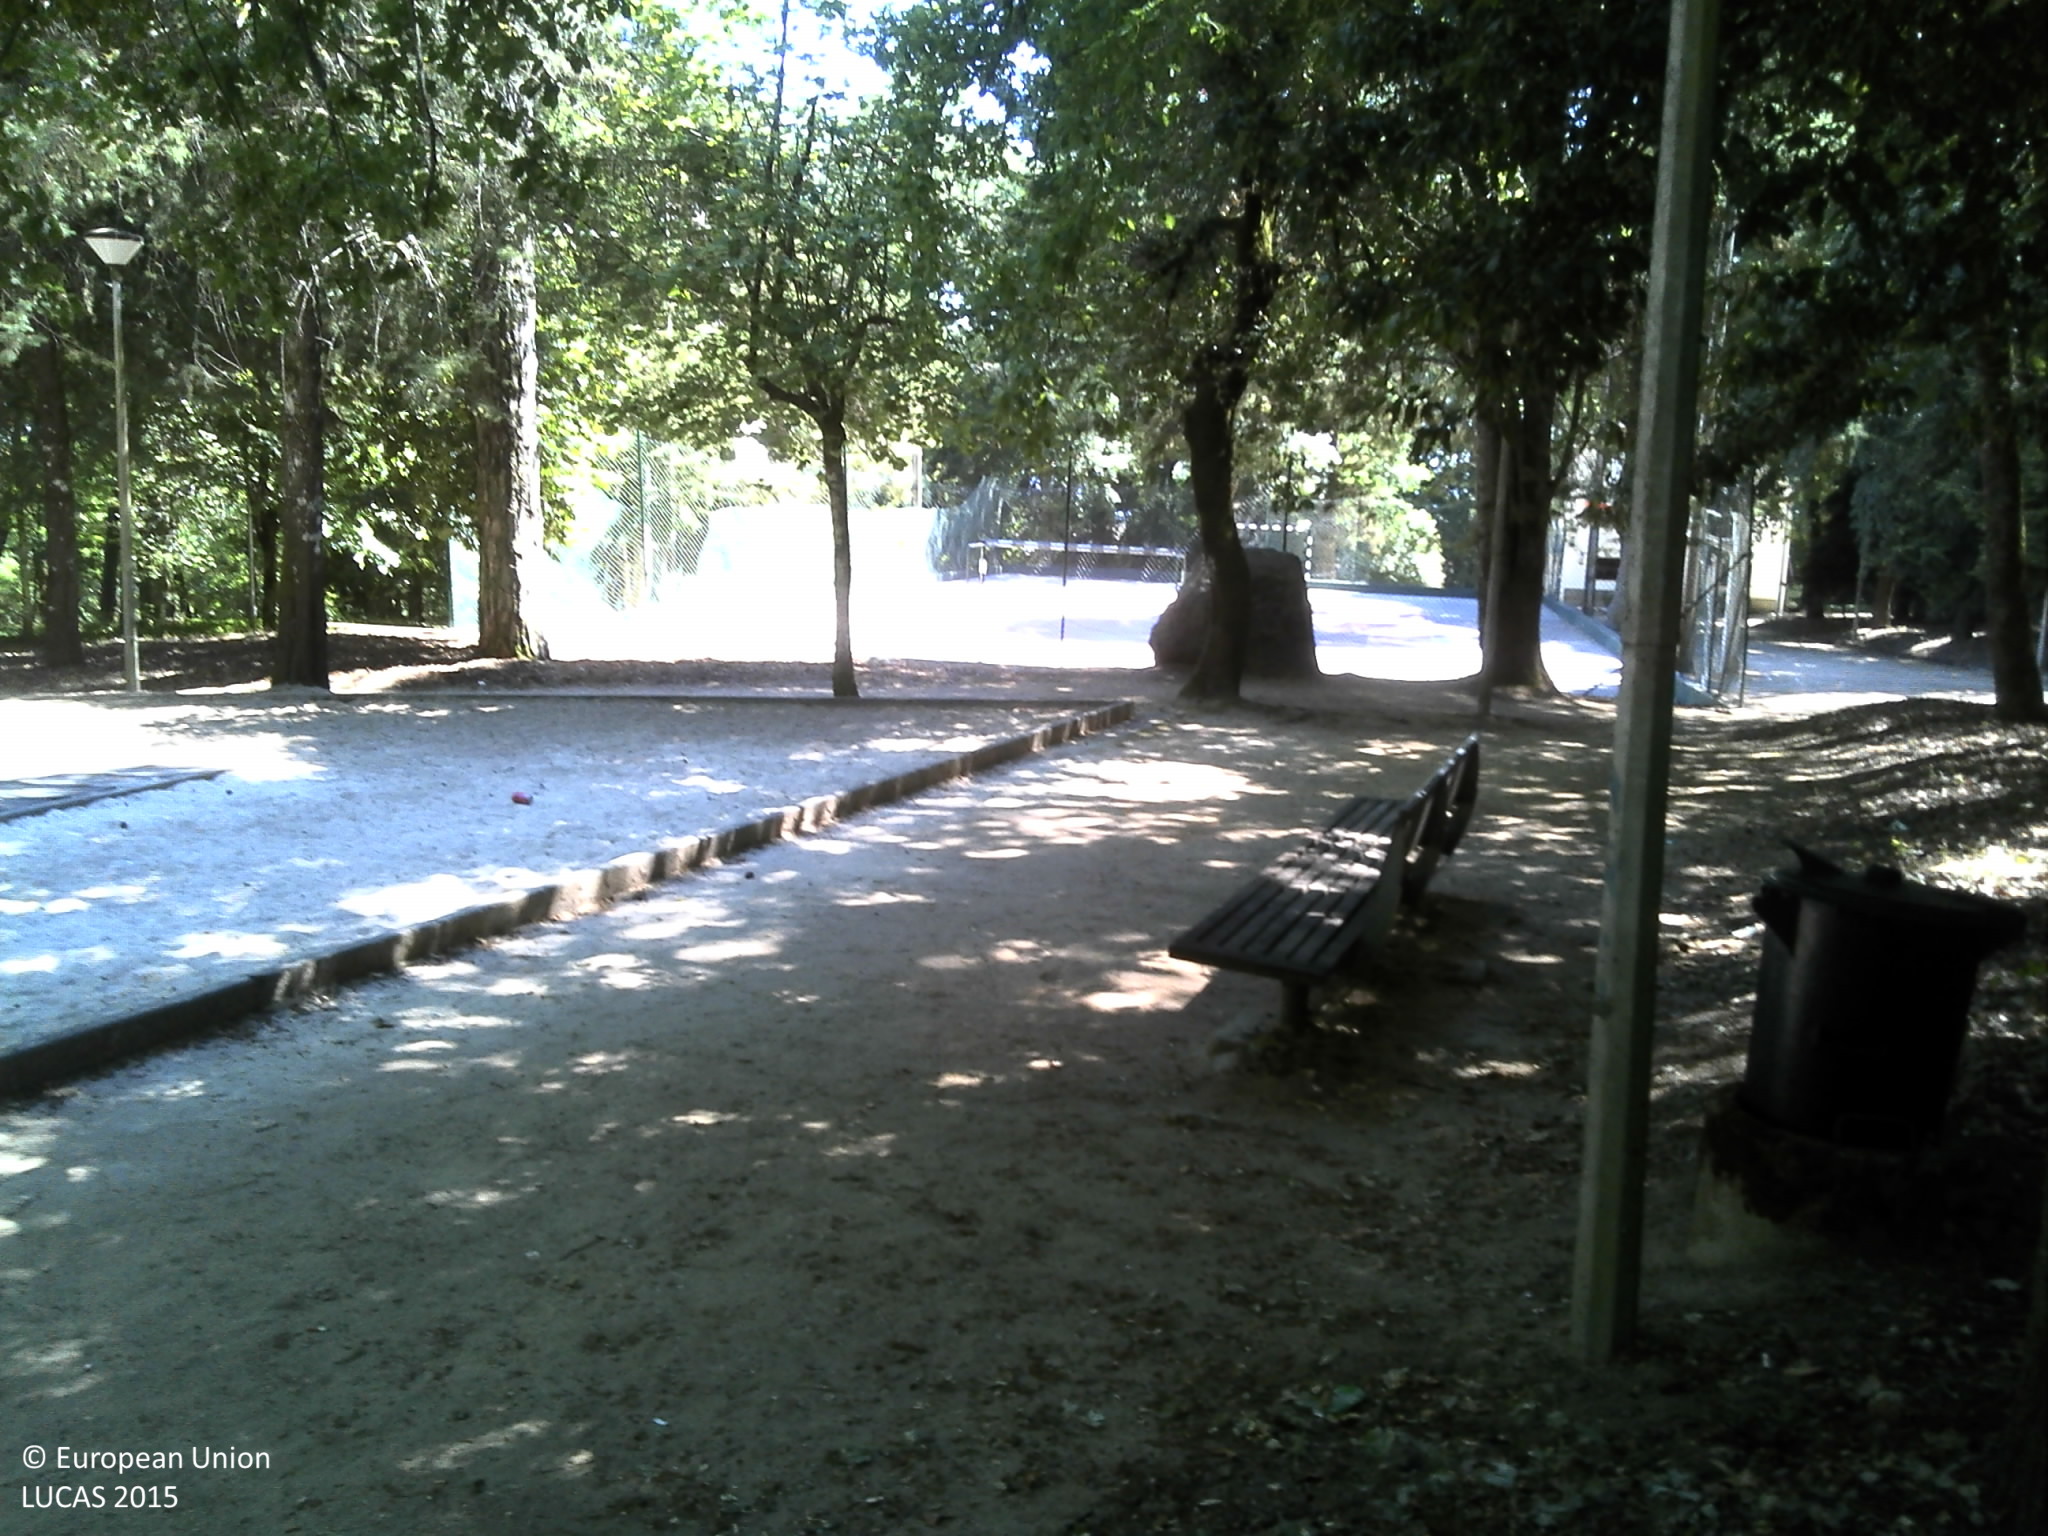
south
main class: Woodland
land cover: Broadleaved woodland
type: thermophilous deciduous forest
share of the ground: 50 - 75 %
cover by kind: broadleaved forest trees 50 %, herbaceous plants 25 %, unconsolidated bare surface 20 %, coniferous forest trees 5 %
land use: Amenities, museums, leisure
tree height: > 5 m
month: June
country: PT
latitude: 40.7742
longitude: -7.3509
